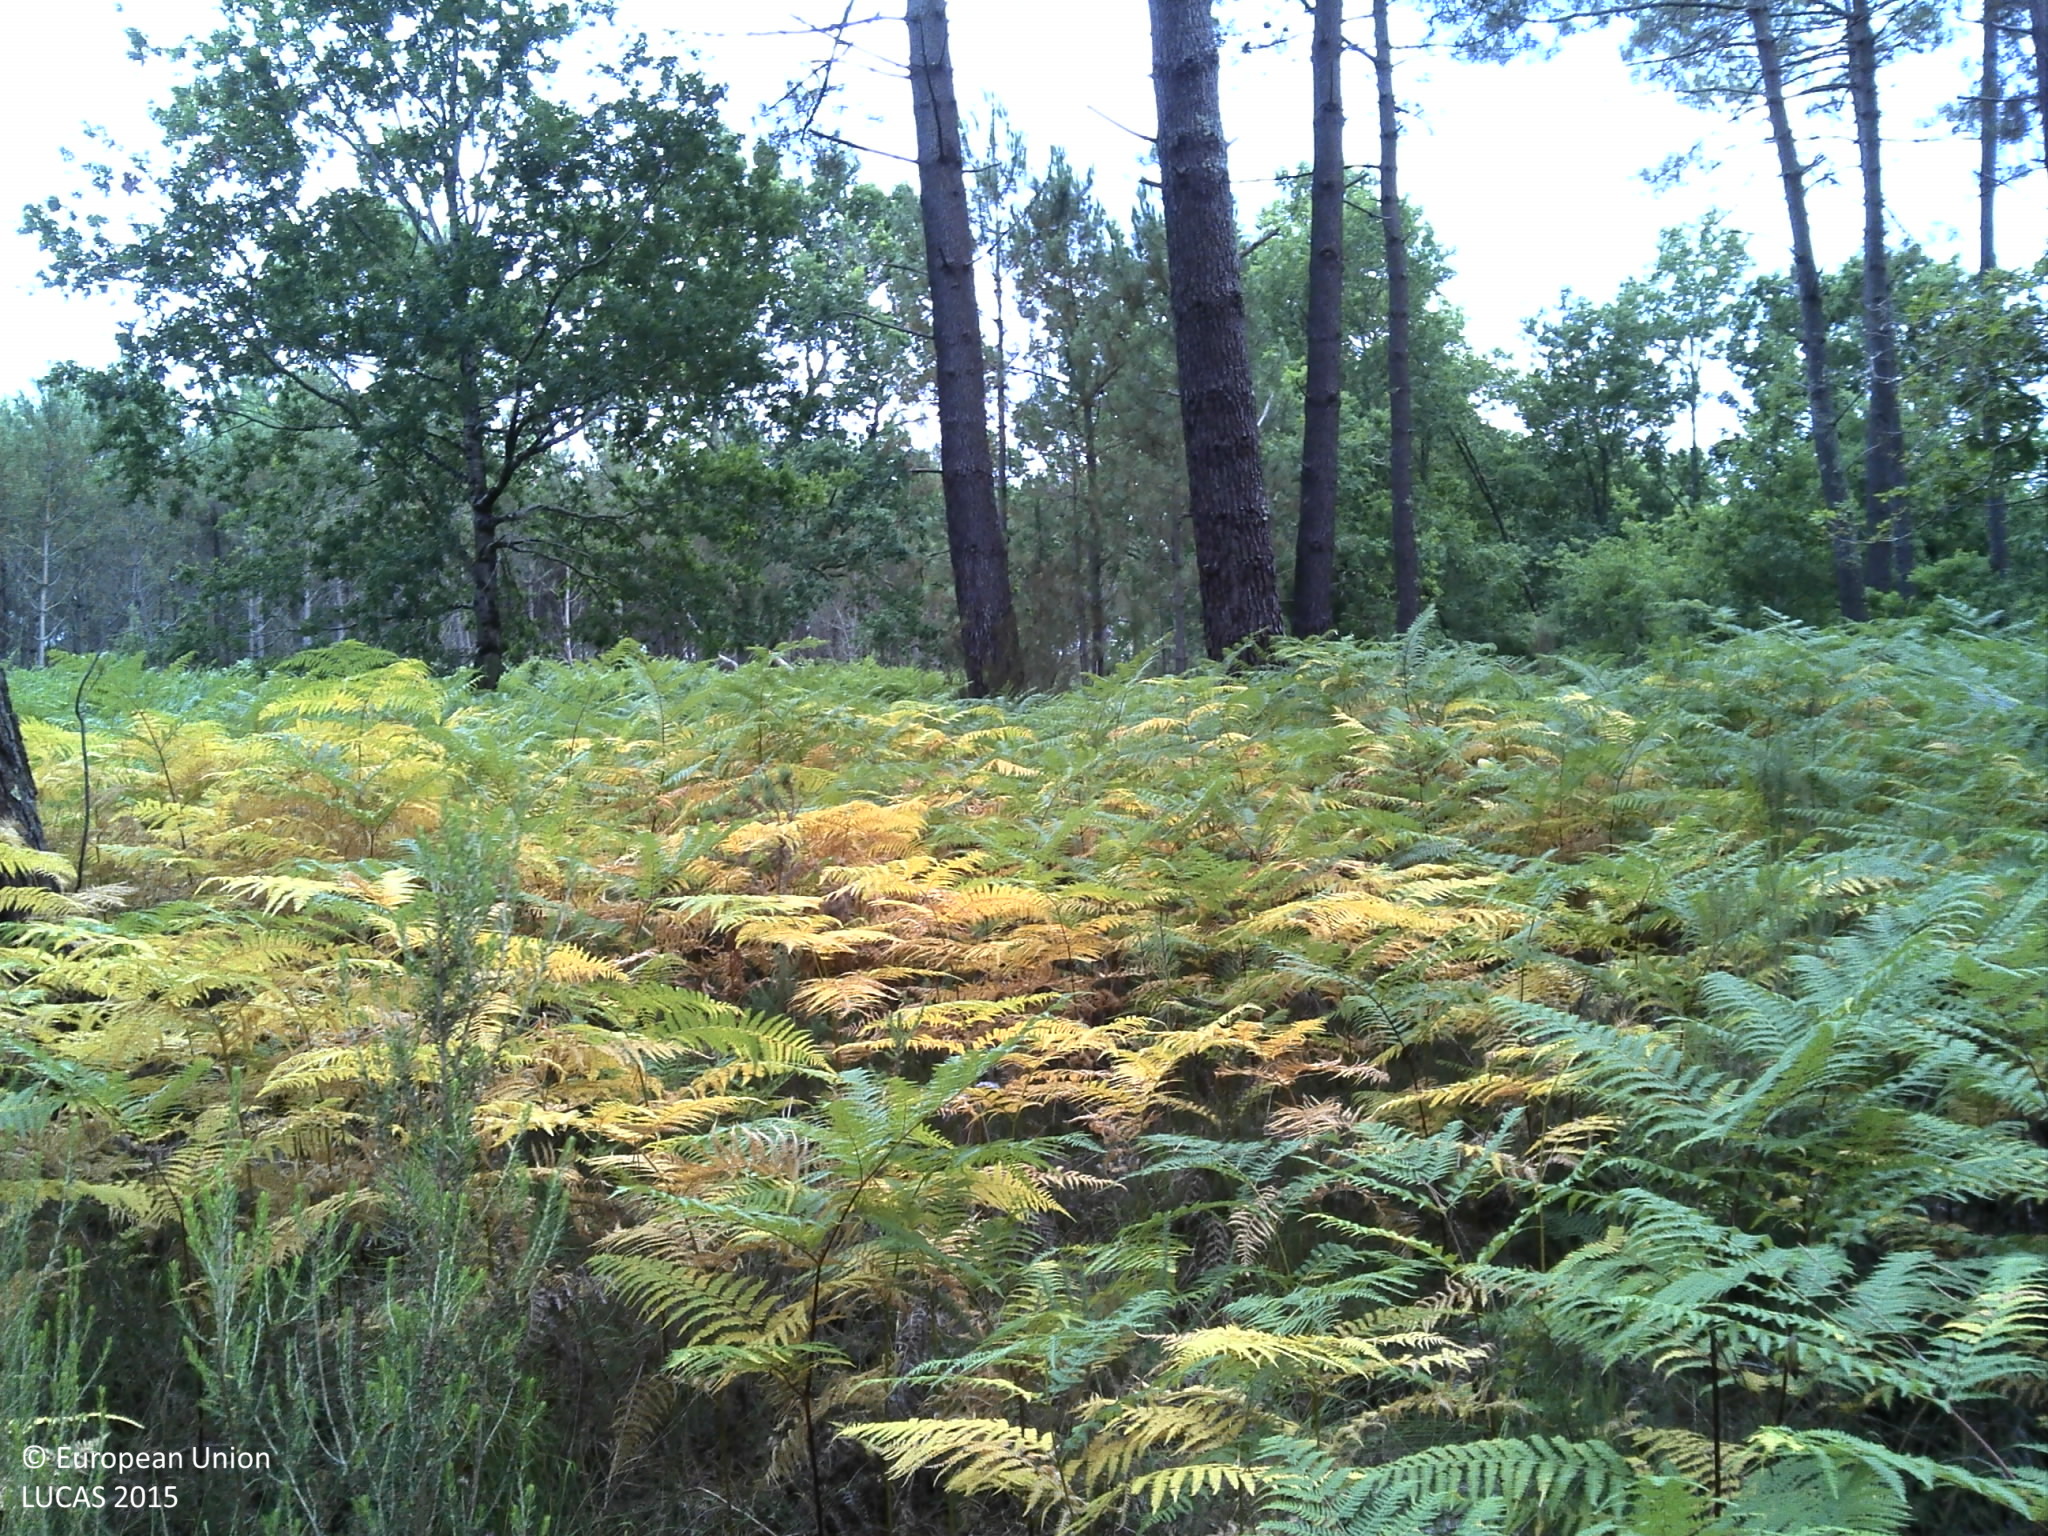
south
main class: Woodland
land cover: Pine dominated coniferous woodland
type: coniferous forest of the mediterranean region
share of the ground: > 75 %
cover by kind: shrubs 50 %, coniferous forest trees 40 %, lichens and mosses 10 %
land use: Forestry
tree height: > 5 m
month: July
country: FR
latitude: 45.0898
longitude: -1.0148
